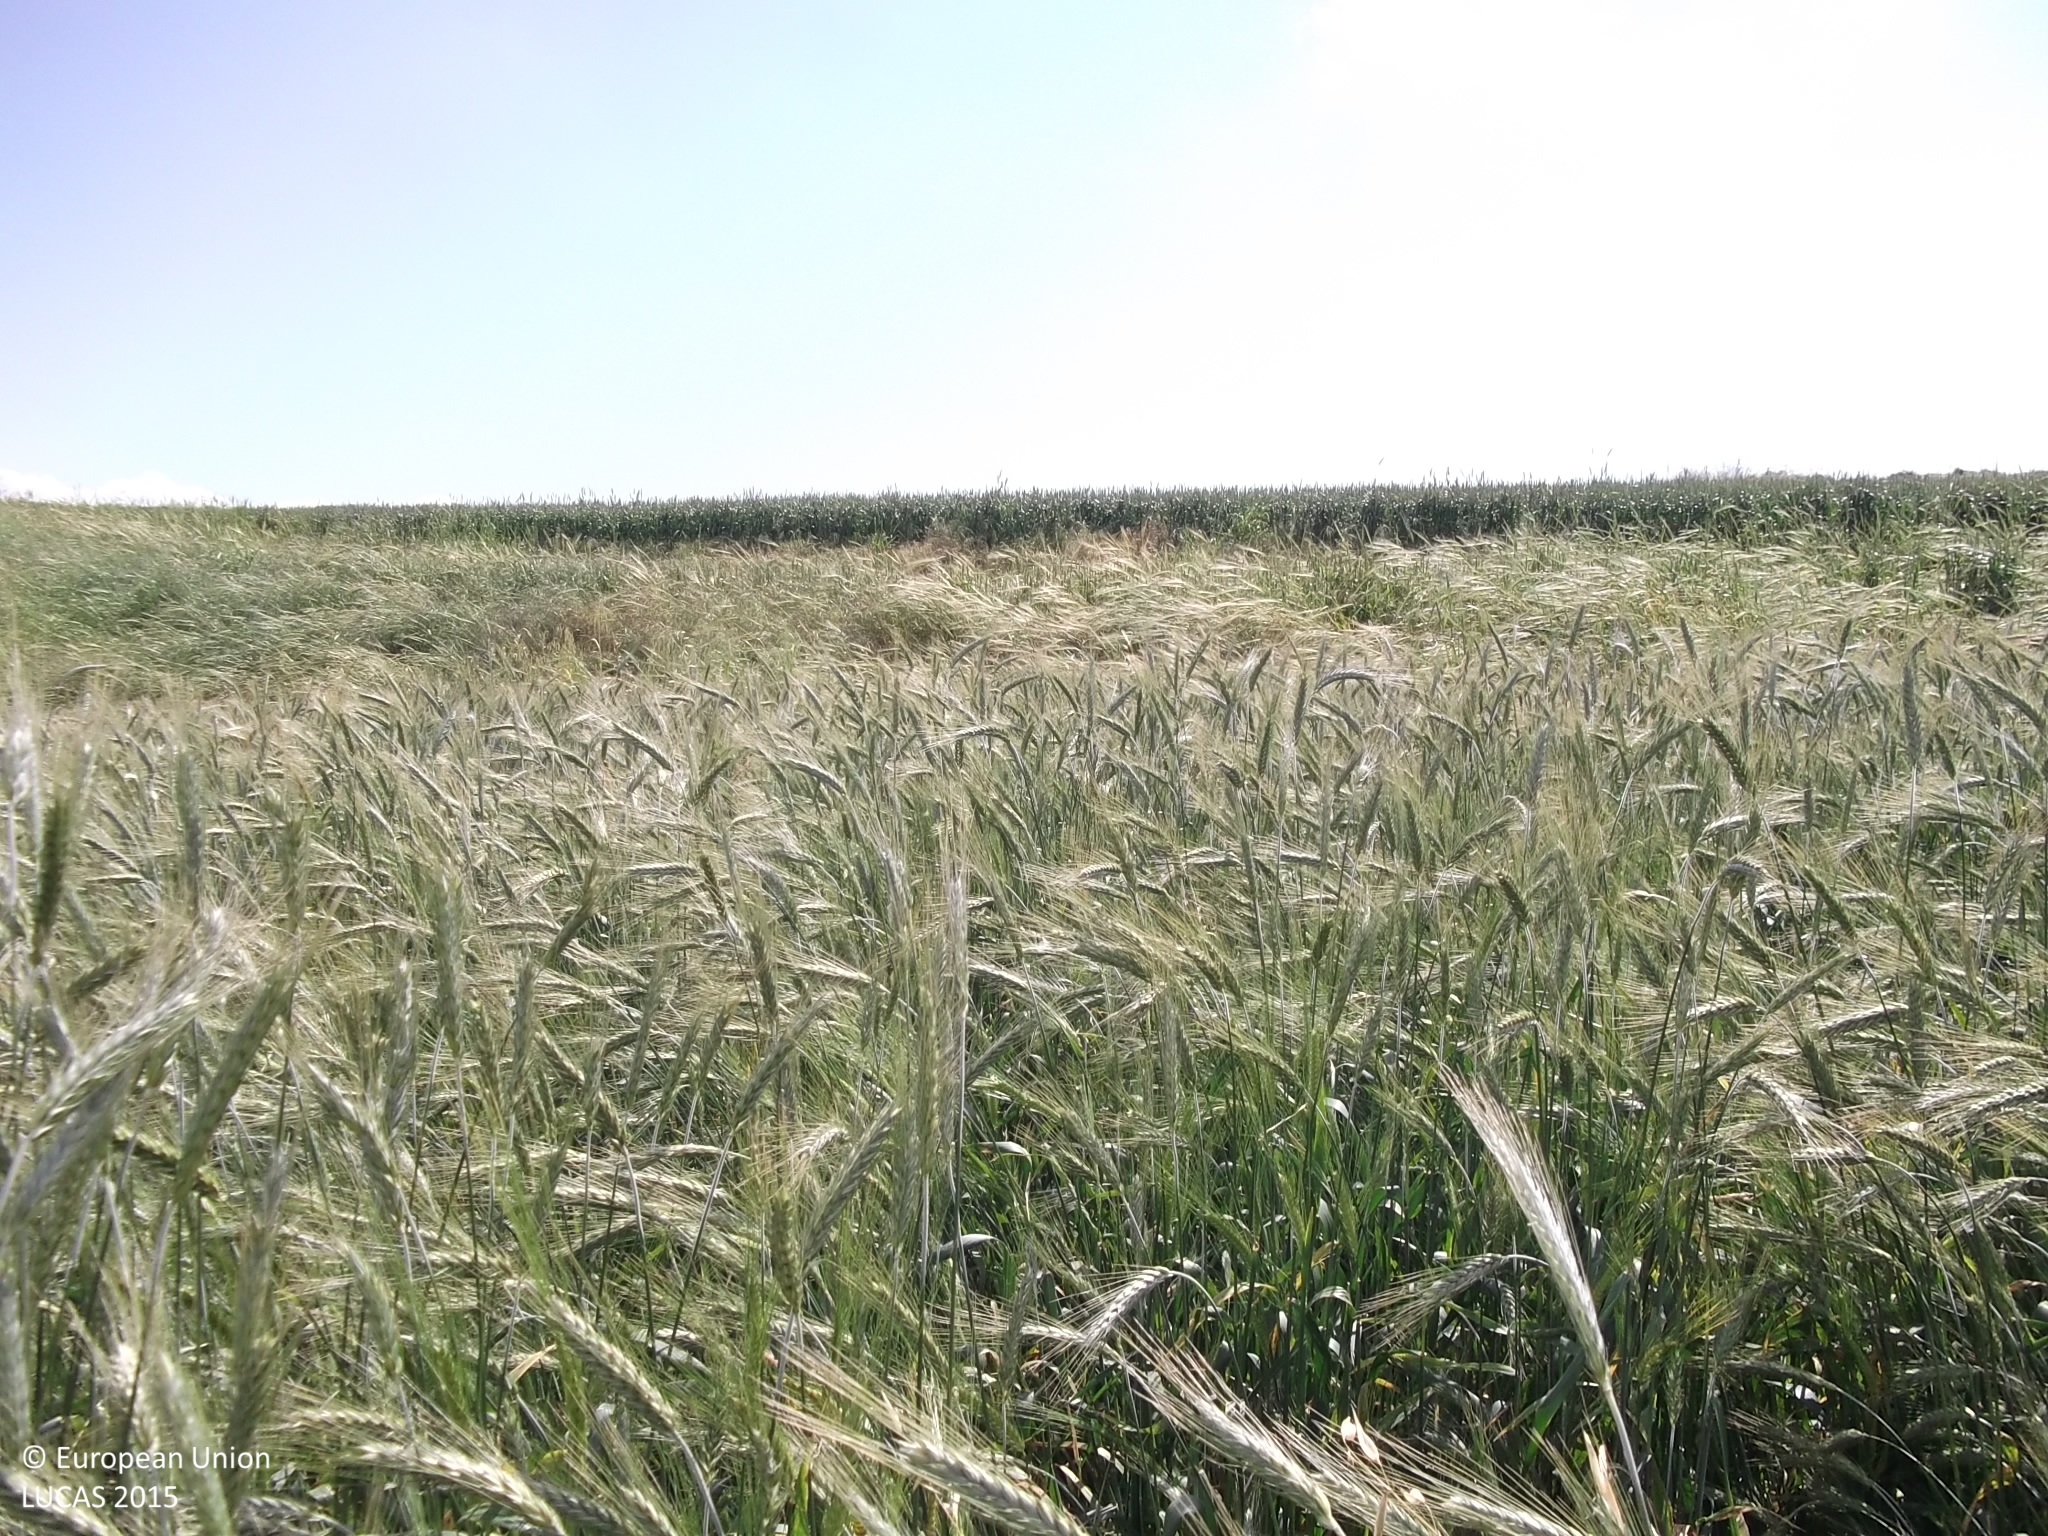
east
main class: Cropland
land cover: Common wheat
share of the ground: > 75 %
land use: Agriculture (excluding fallow land and kitchen gardens)
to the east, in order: Common wheat; Rock outcrops; Barley; Rock outcrops; Paved roads, cycling and walking lanes; Rye; Spontaneously vegetated surfaces; Barley; Spontaneously vegetated surfaces; Shrubland without tree cover
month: April
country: CY
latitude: 34.9806
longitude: 33.5839
